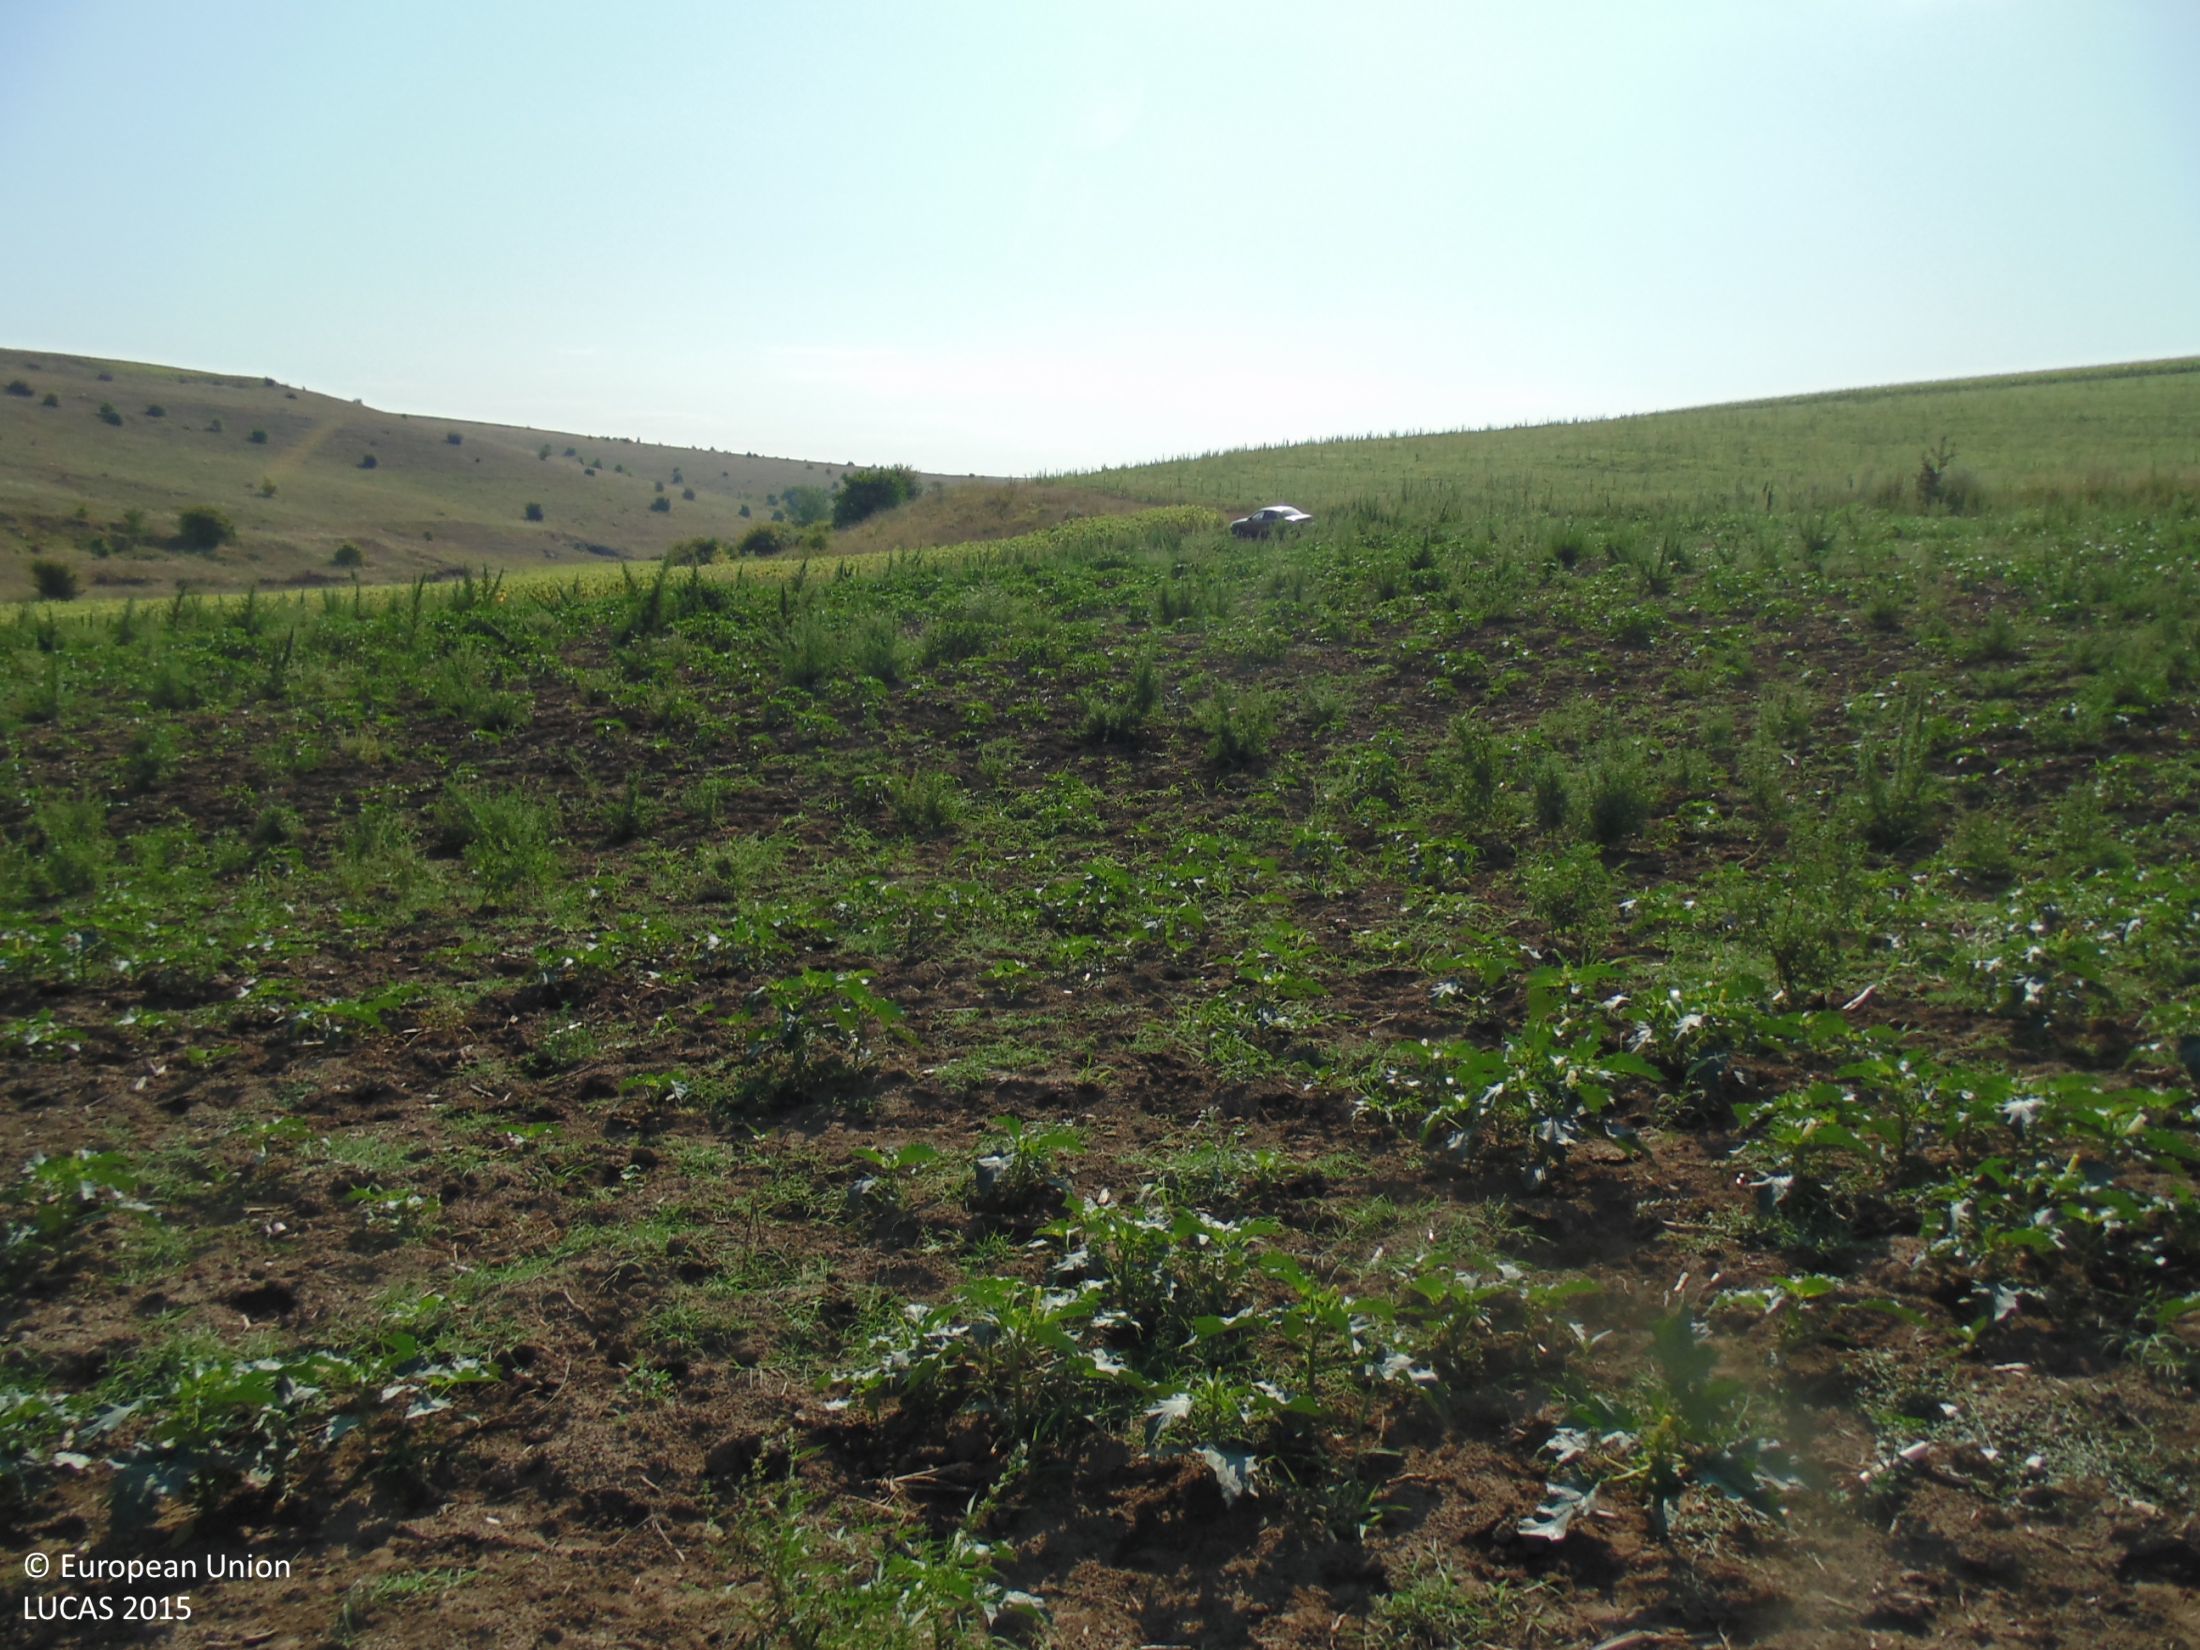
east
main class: Grassland
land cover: Spontaneously vegetated surfaces
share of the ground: 50 - 75 %
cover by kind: herbaceous plants 70 %, unconsolidated bare surface 30 %
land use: Fallow land
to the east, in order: Spontaneously vegetated surfaces; Tracks; Grass margins; Sunflower; Grassland with sparse tree/shrub cover; Sunflower
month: August
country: BG
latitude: 43.8740
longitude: 27.7520
